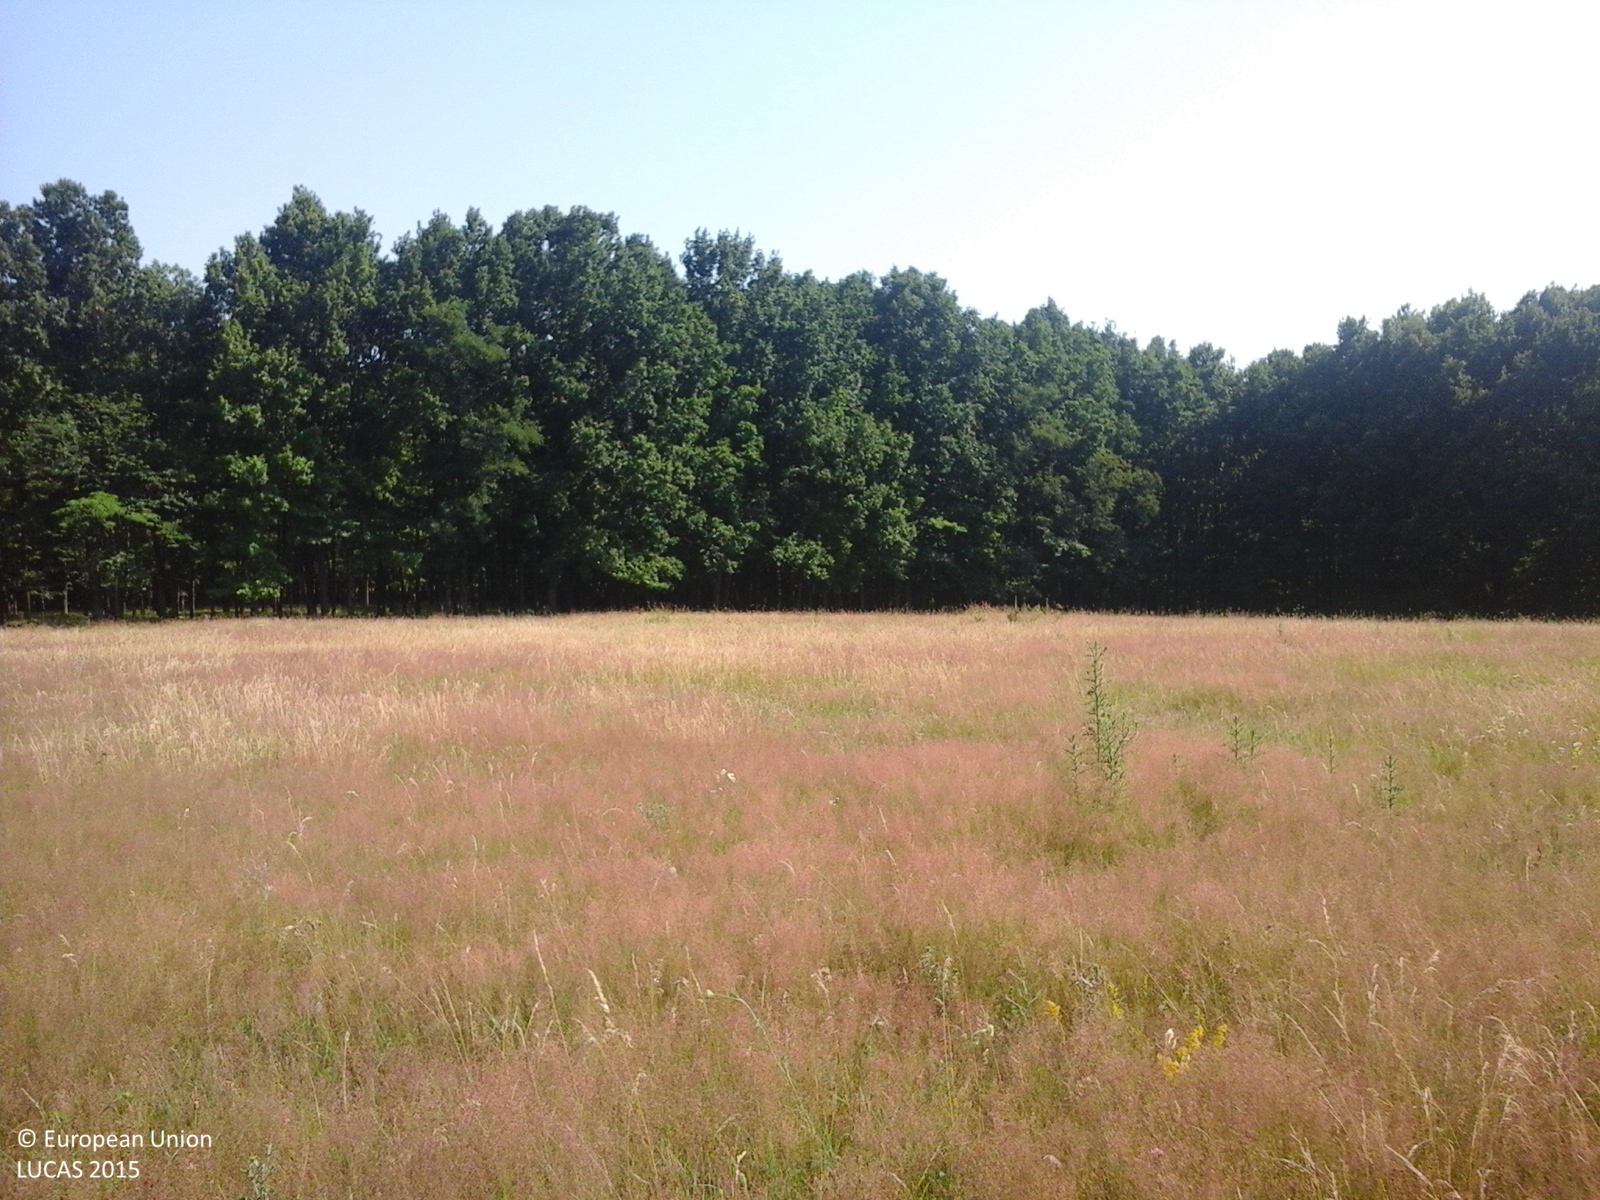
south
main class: Grassland
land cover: Grassland without tree/shrub cover
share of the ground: > 75 %
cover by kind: herbaceous plants 100 %
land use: Agriculture (excluding fallow land and kitchen gardens)
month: July
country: RO
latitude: 44.8539
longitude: 24.6931
